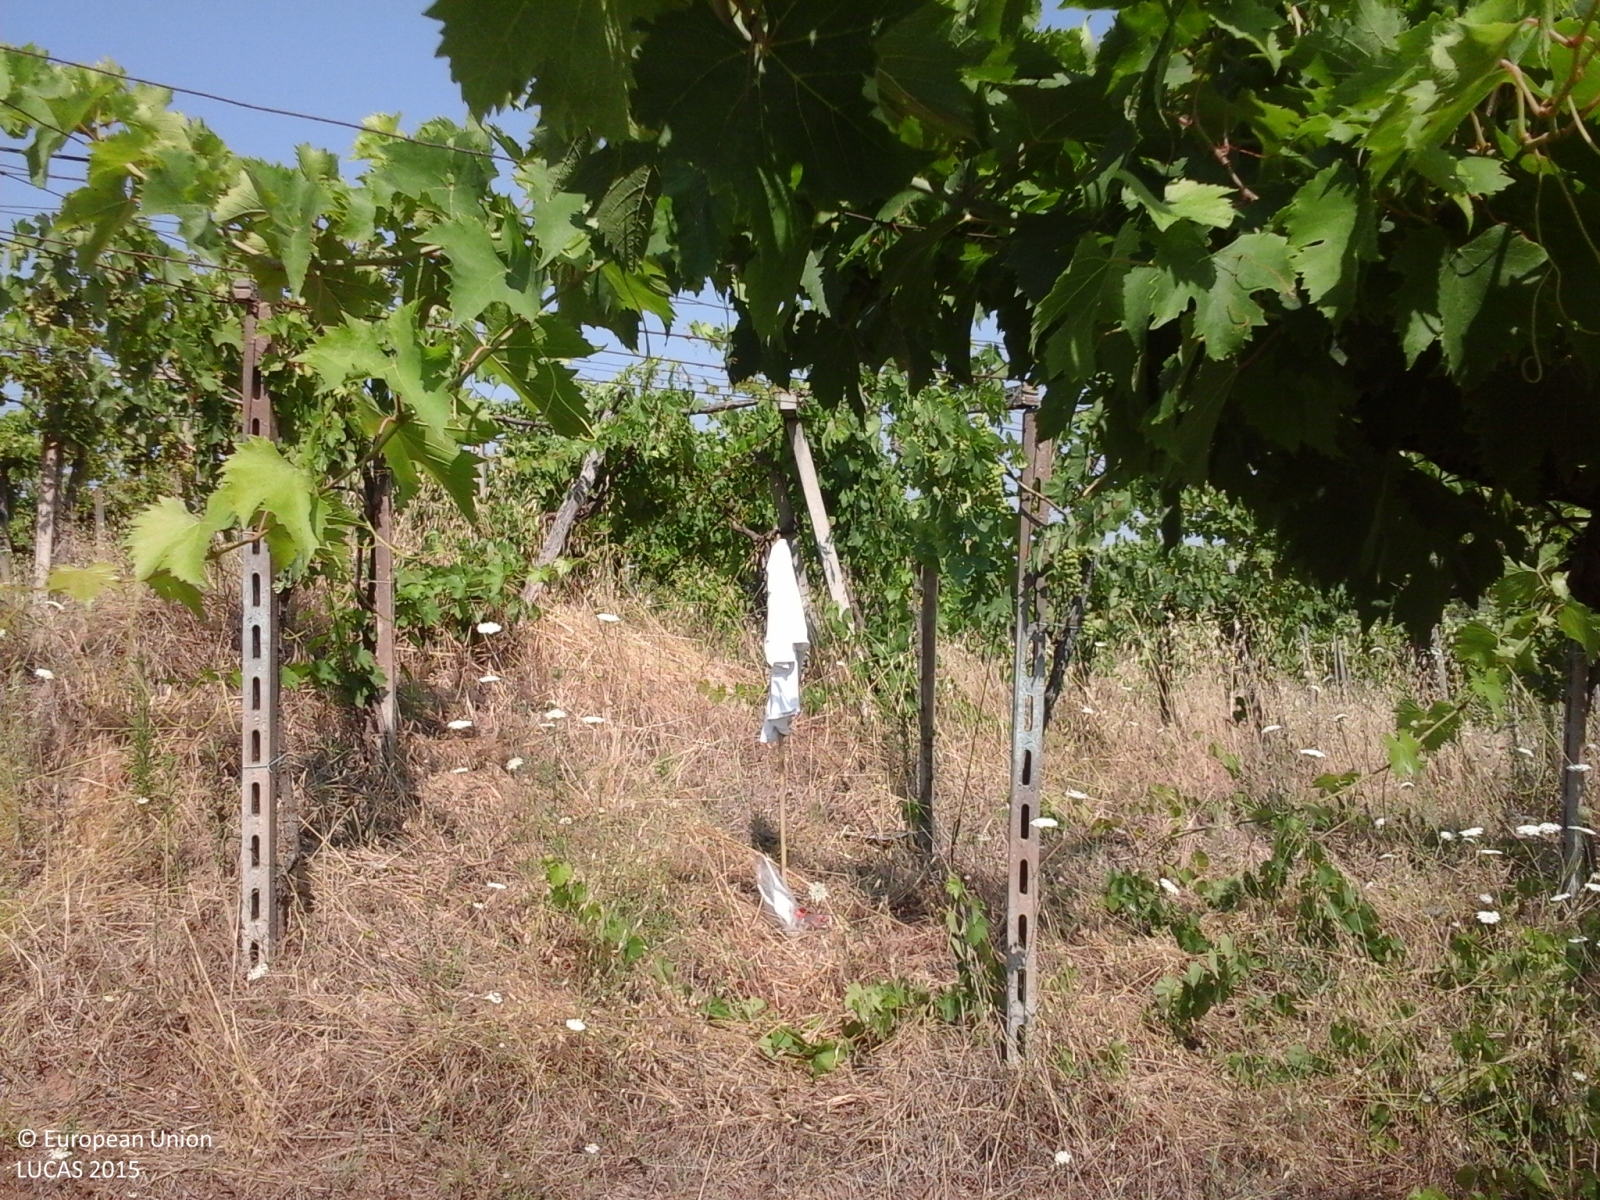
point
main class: Cropland
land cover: Vineyards
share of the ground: 50 - 75 %
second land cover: Spontaneously vegetated surfaces
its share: > 75 %
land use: Agriculture (excluding fallow land and kitchen gardens)
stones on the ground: 10 - 25 %
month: July
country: IT
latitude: 42.4200
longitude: 14.2531
